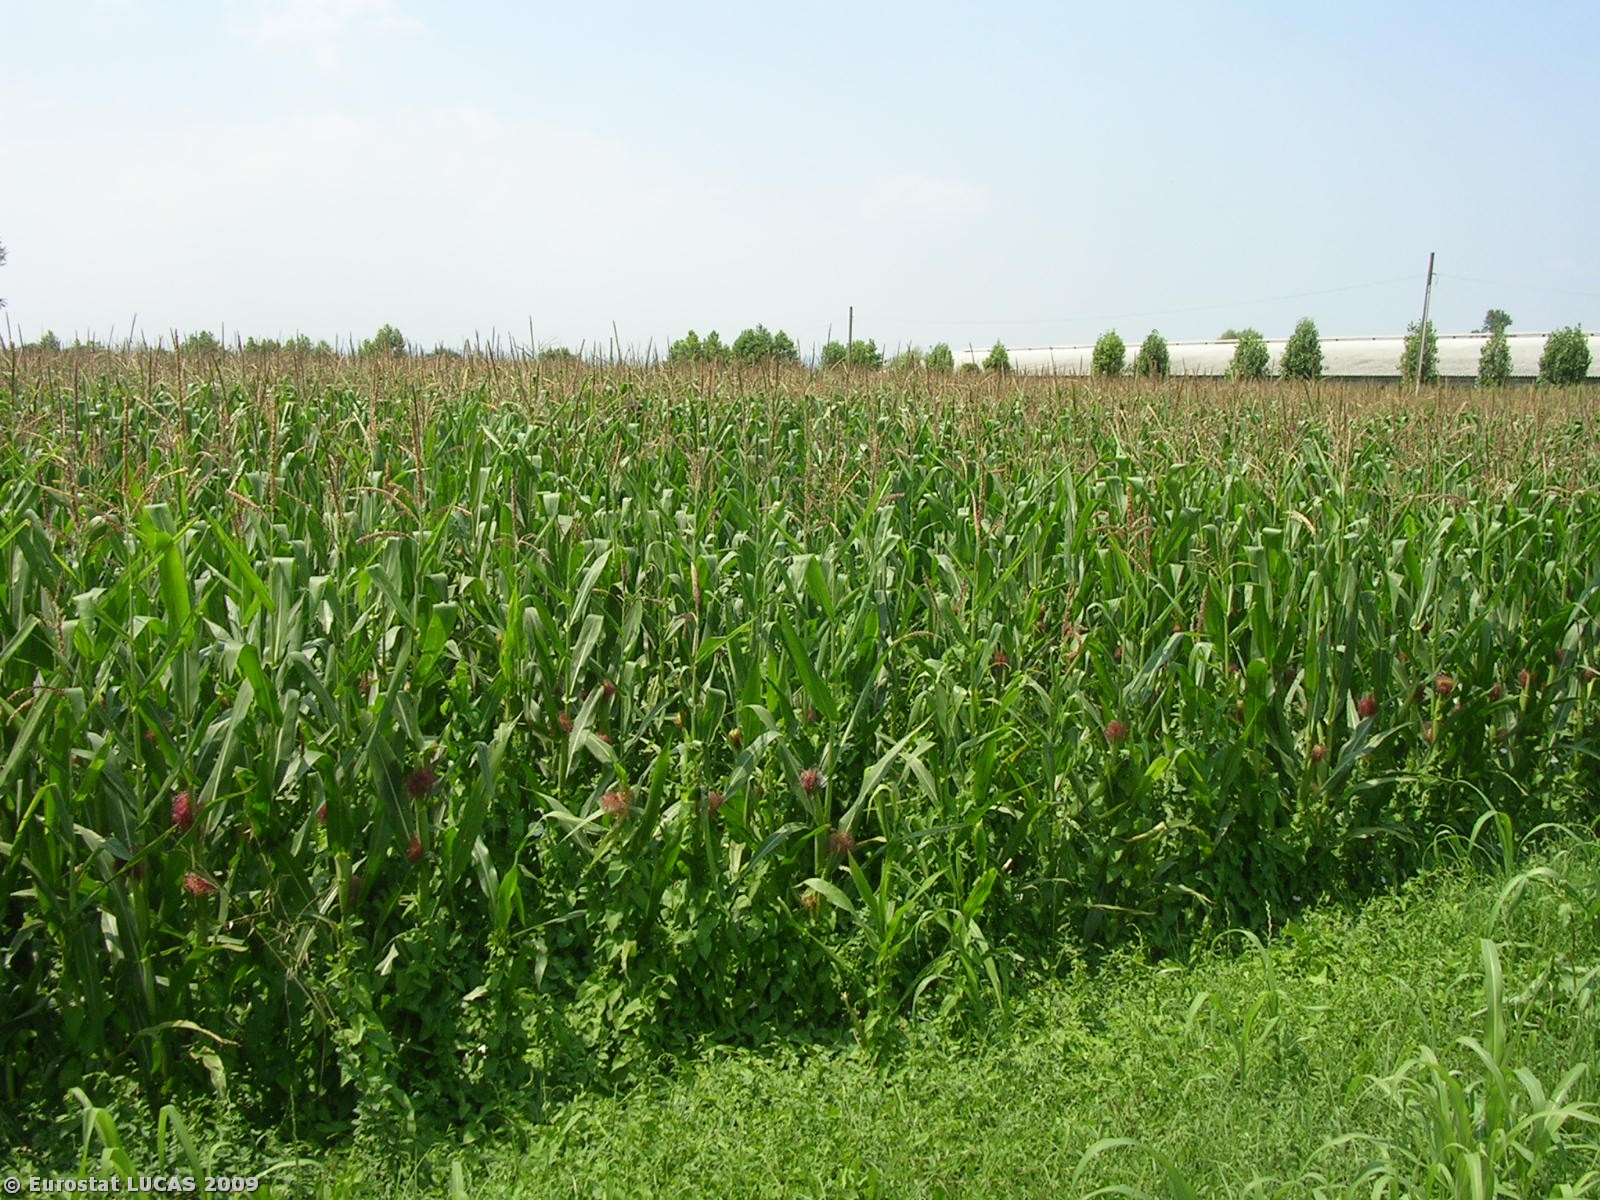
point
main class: Cropland
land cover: Maize
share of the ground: > 75 %
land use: Agriculture (excluding fallow land and kitchen gardens)
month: July
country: IT
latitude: 45.4539
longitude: 11.7490
